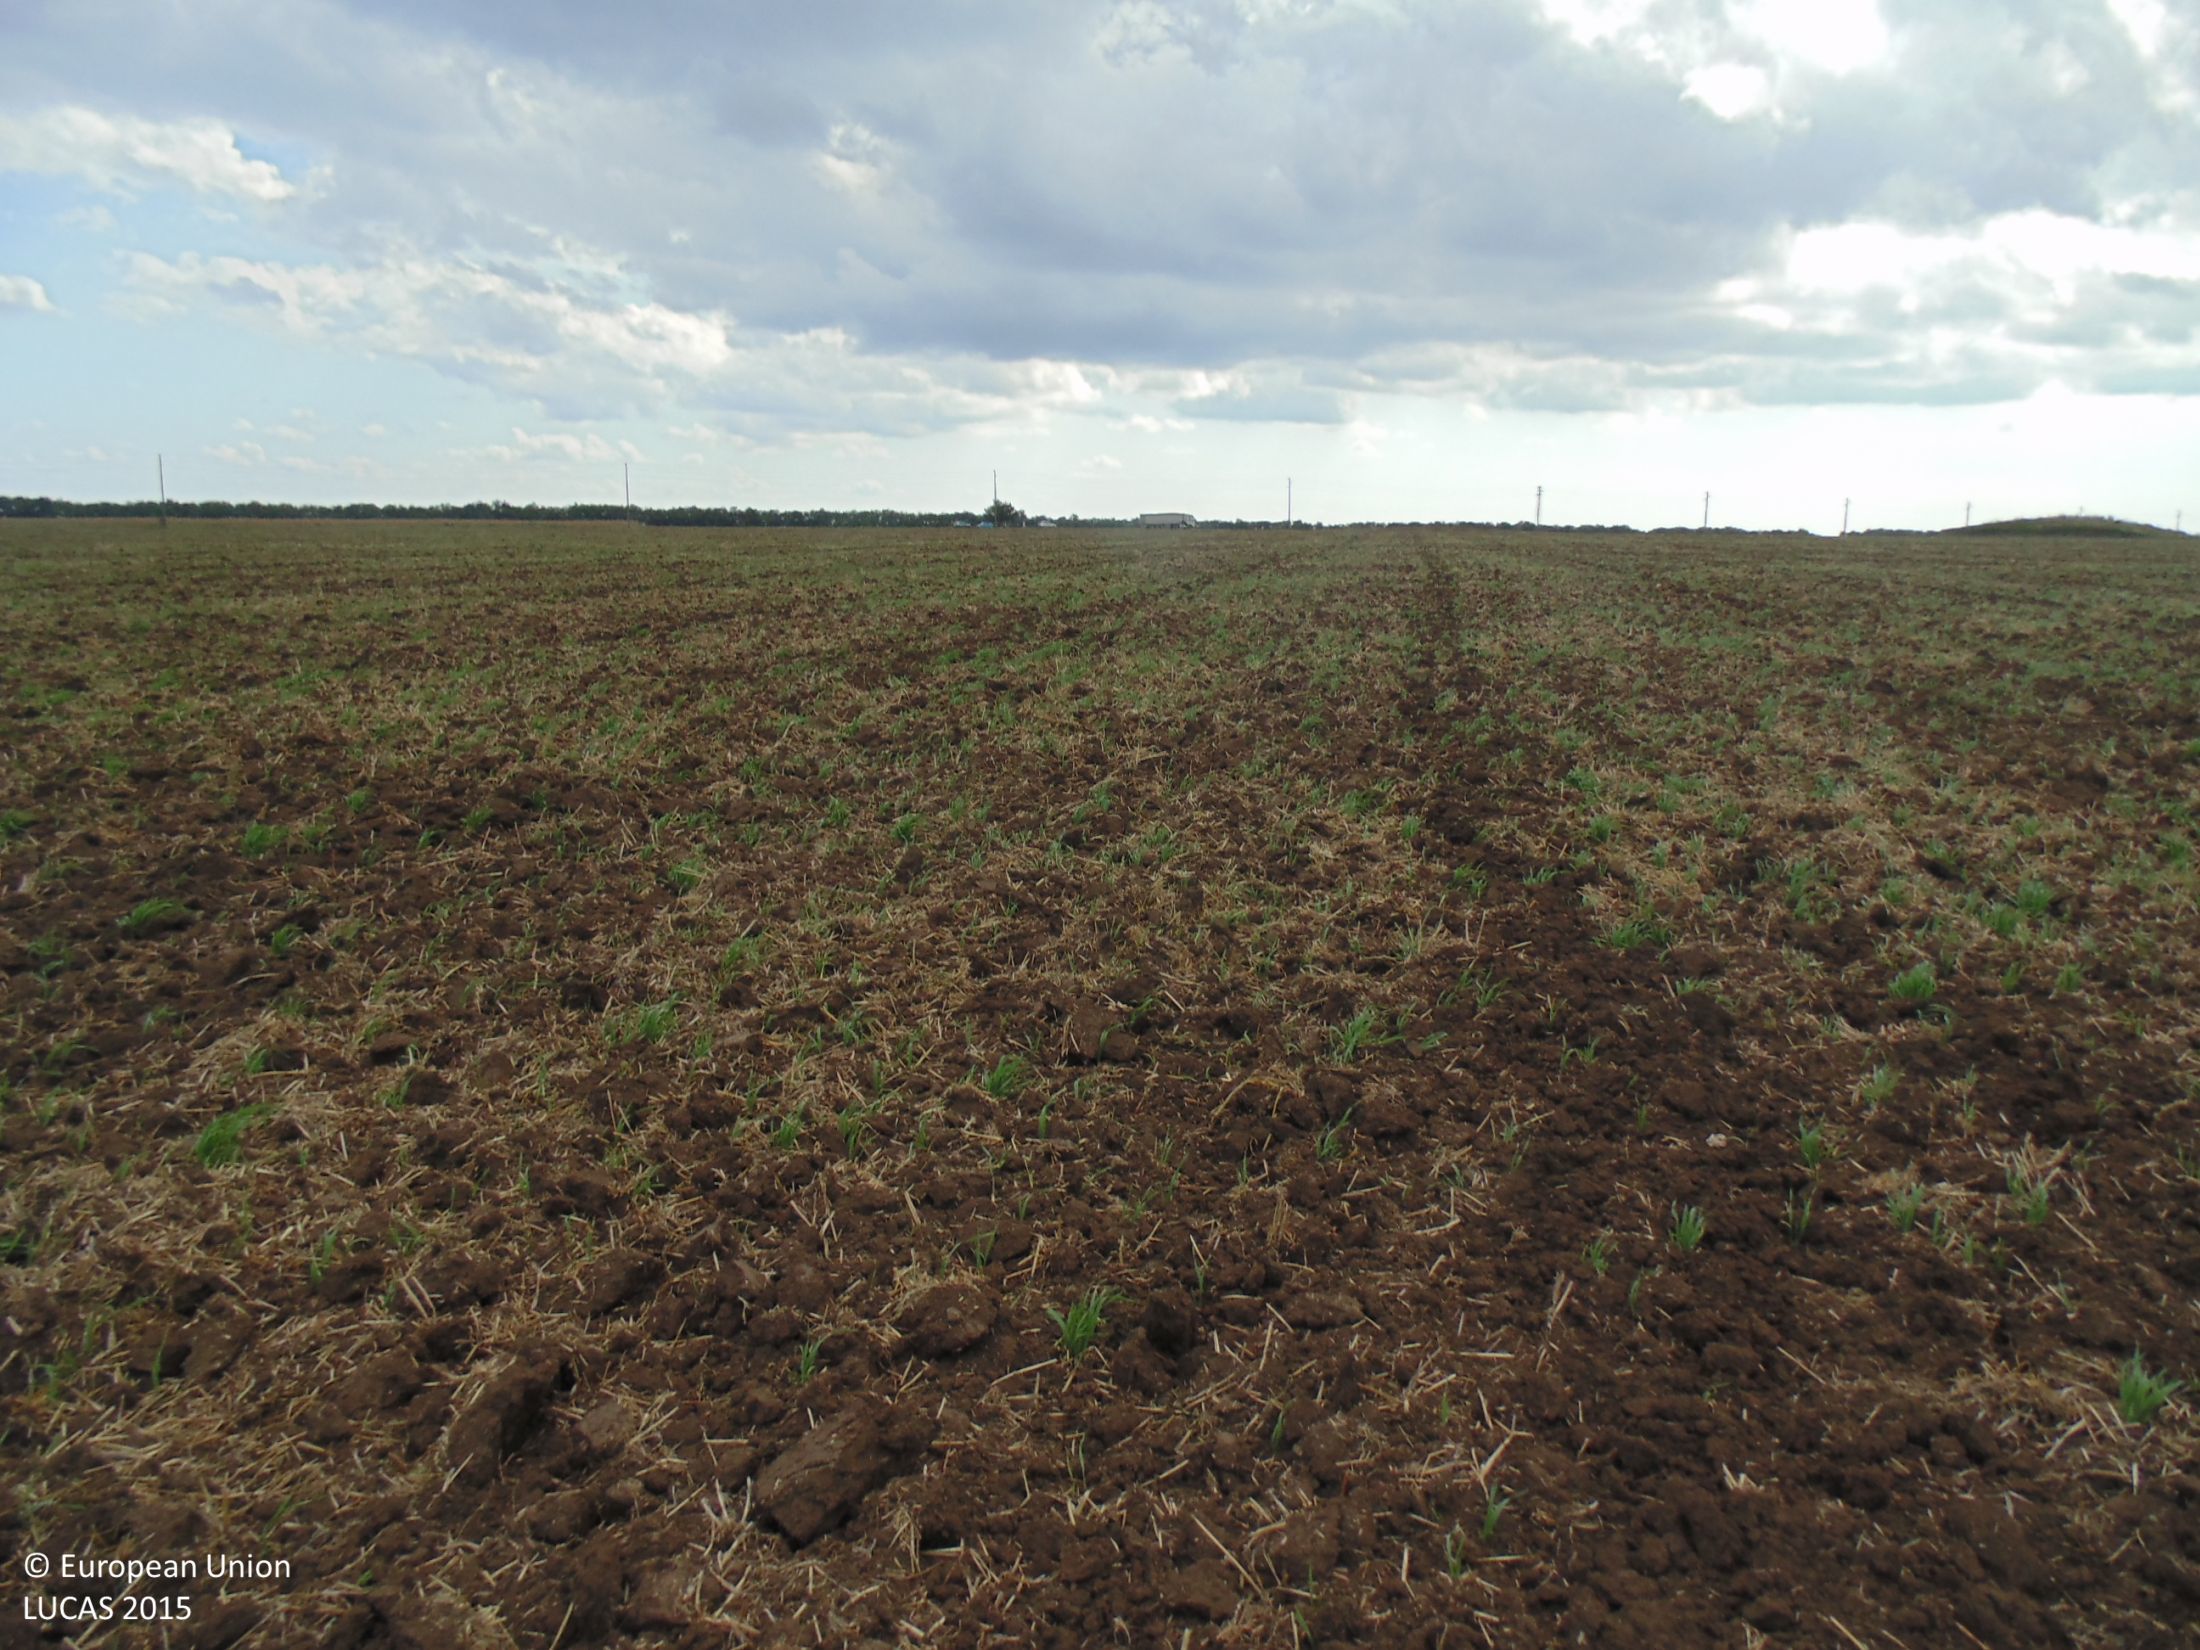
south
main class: Cropland
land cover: Common wheat
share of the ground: < 10 %
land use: Agriculture (excluding fallow land and kitchen gardens)
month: September
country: BG
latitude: 43.4432
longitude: 28.5090
